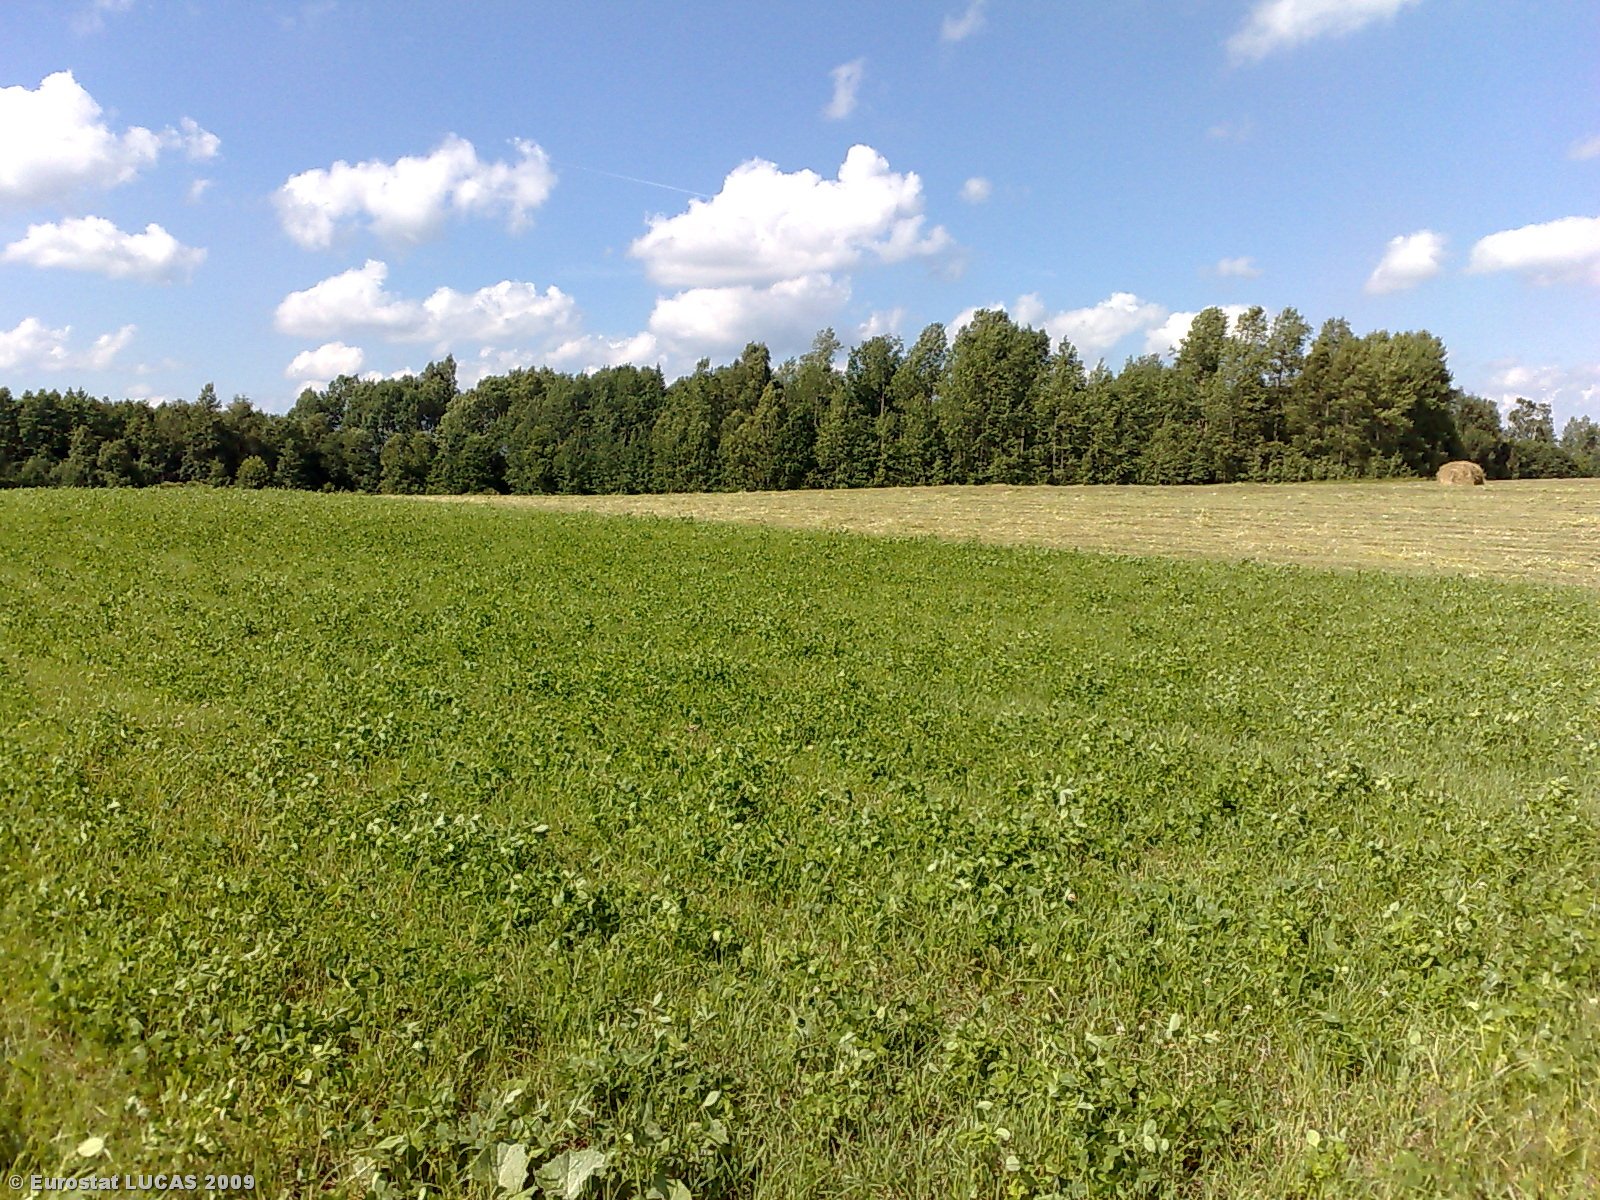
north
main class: Cropland
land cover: Clovers
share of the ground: > 75 %
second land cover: Grassland without tree/shrub cover
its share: 50 - 75 %
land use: Agriculture (excluding fallow land and kitchen gardens)
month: July
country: LT
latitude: 55.5265
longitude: 22.7864
